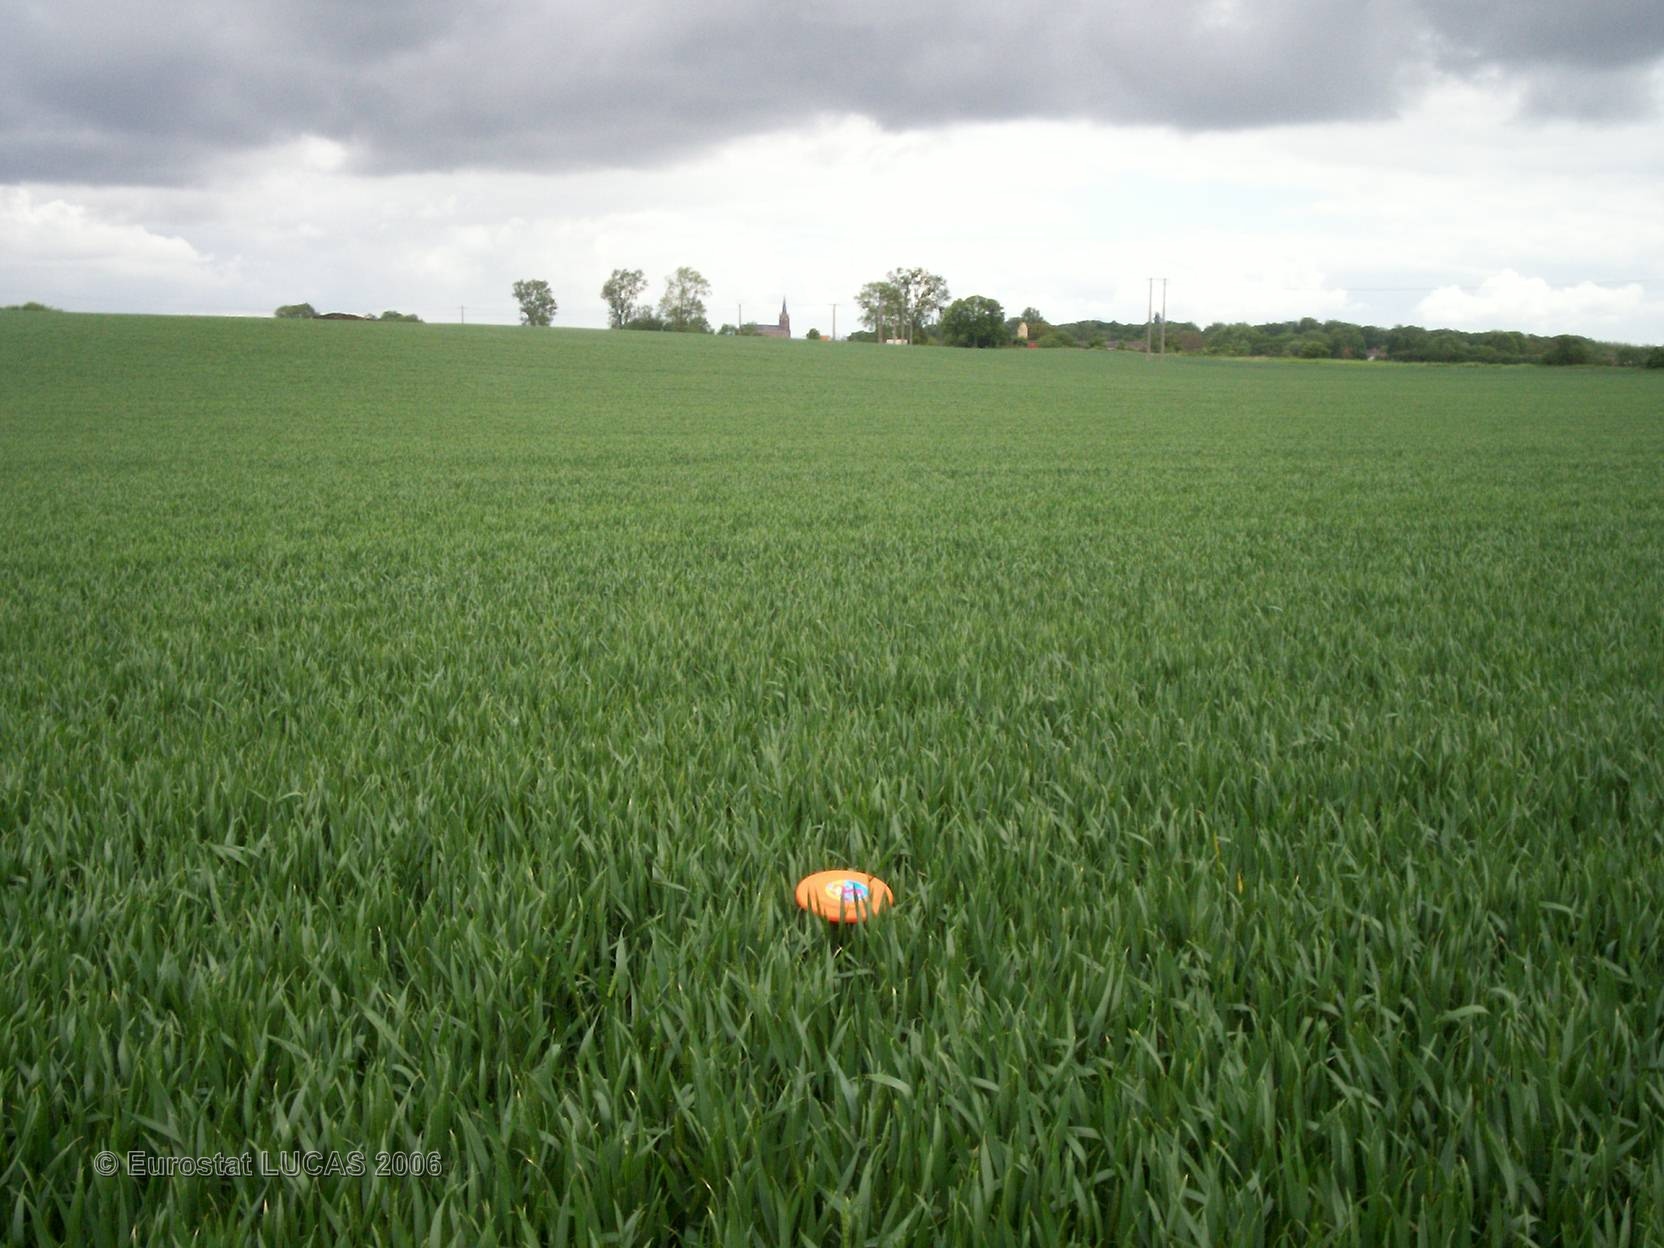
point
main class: Cropland
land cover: Common wheat
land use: Agriculture (excluding fallow land and kitchen gardens)
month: May
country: FR
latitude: 49.7820
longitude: 2.6137
